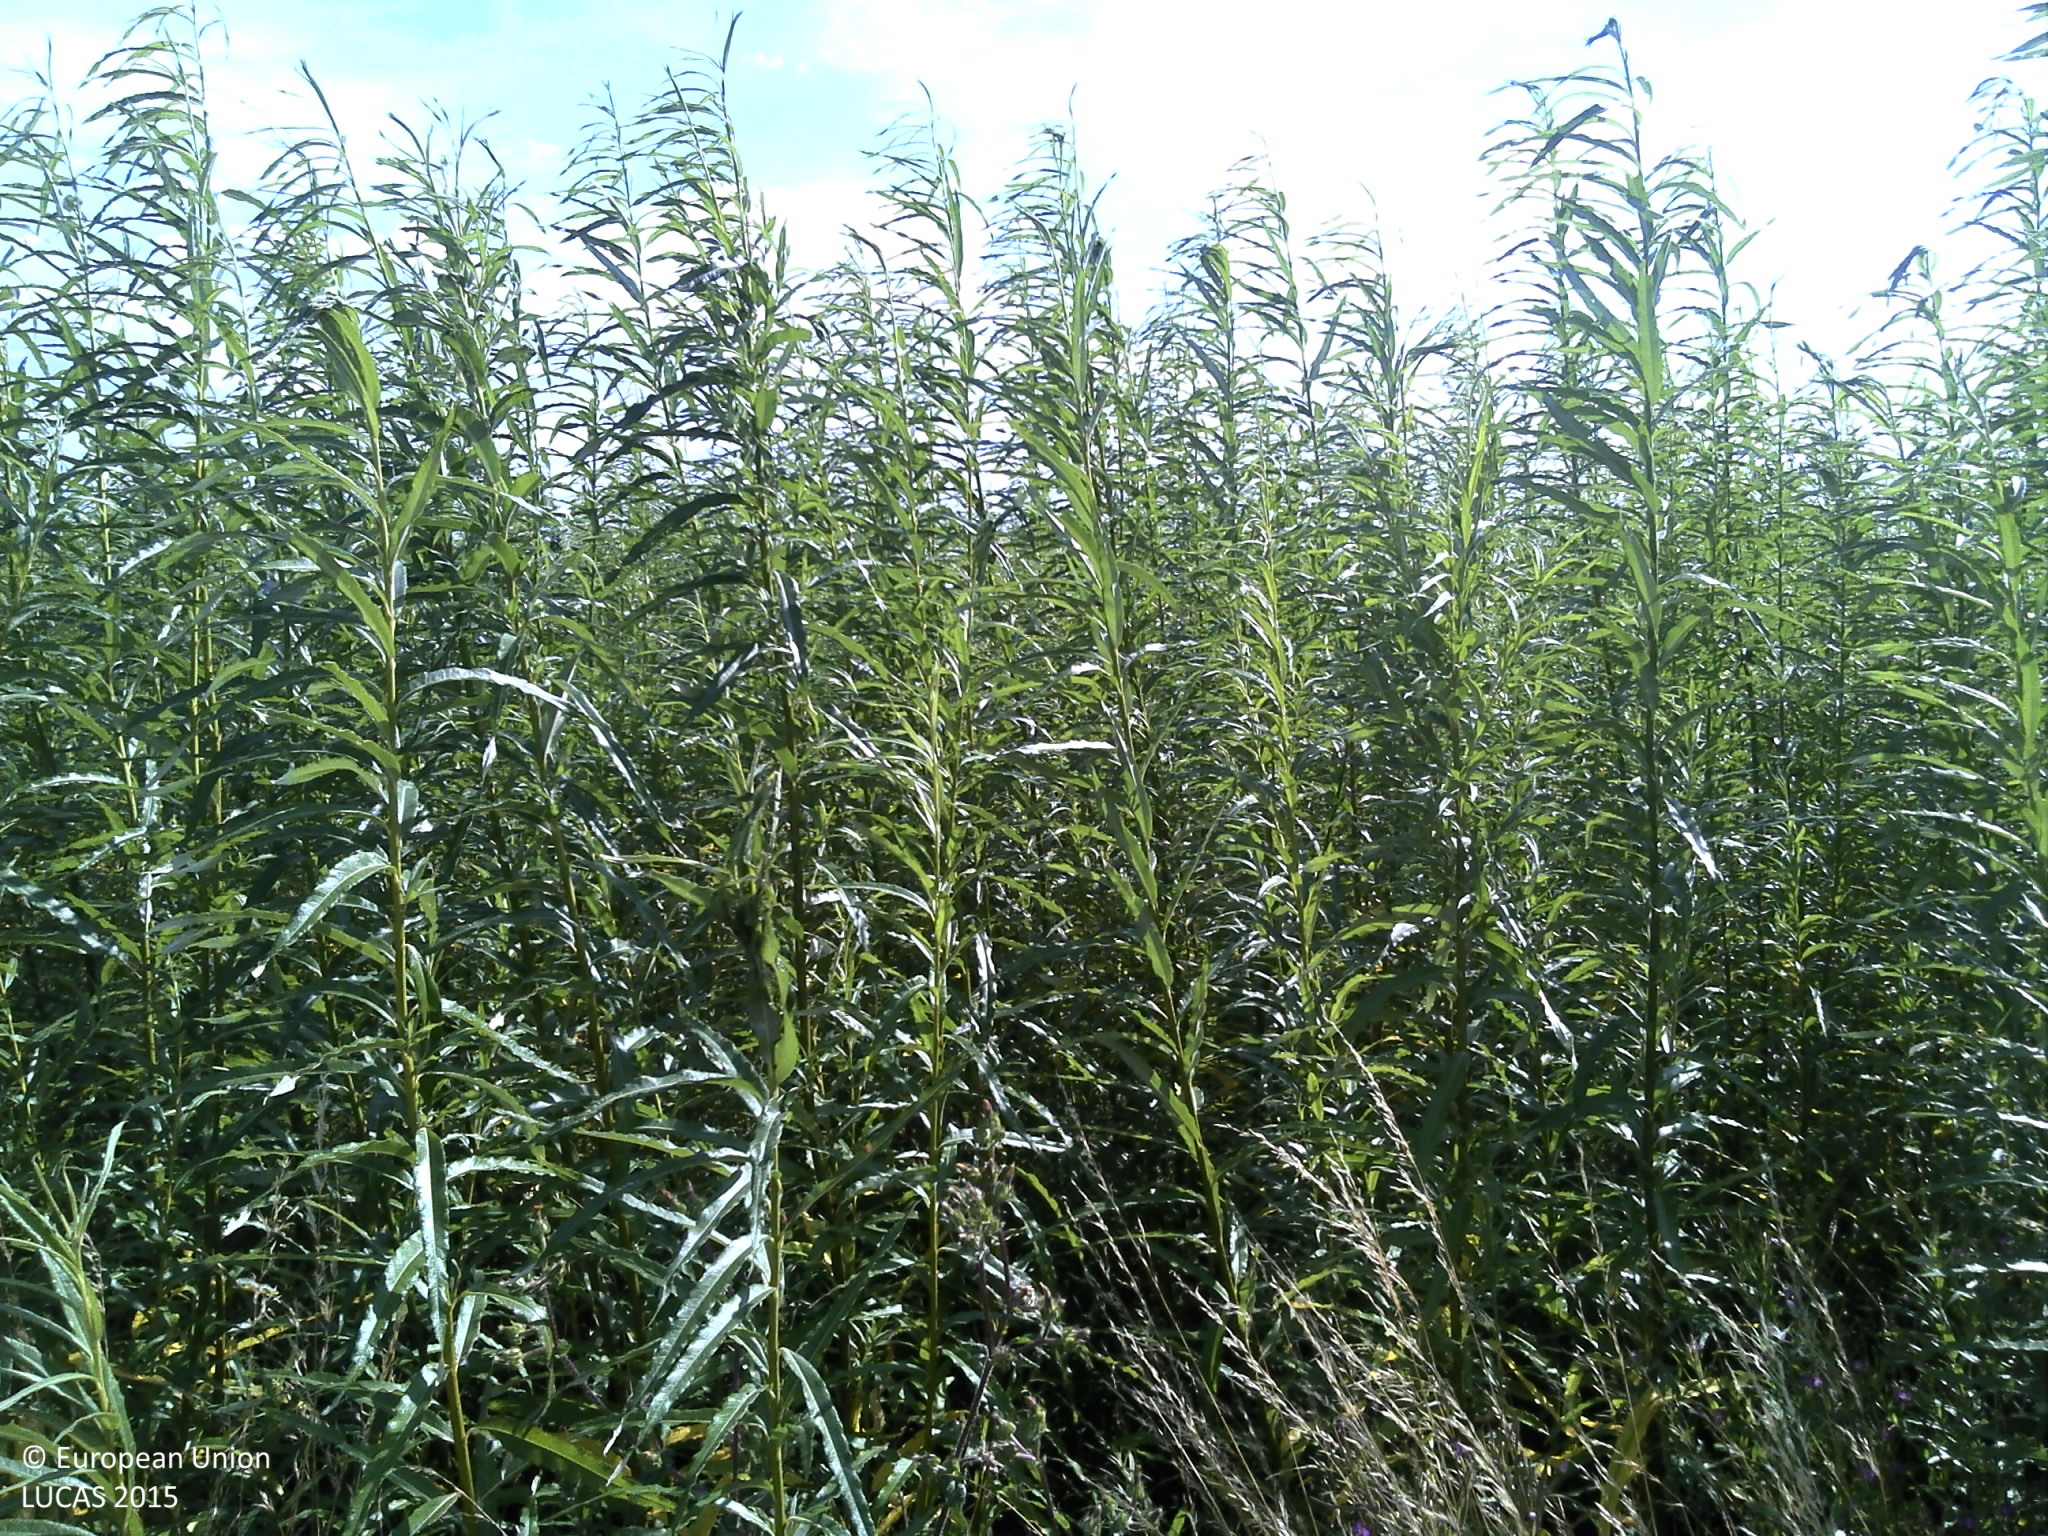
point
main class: Cropland
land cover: Permanent industrial crops
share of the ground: > 75 %
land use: Agriculture (excluding fallow land and kitchen gardens)
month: July
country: FR
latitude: 49.5114
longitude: 4.5132
